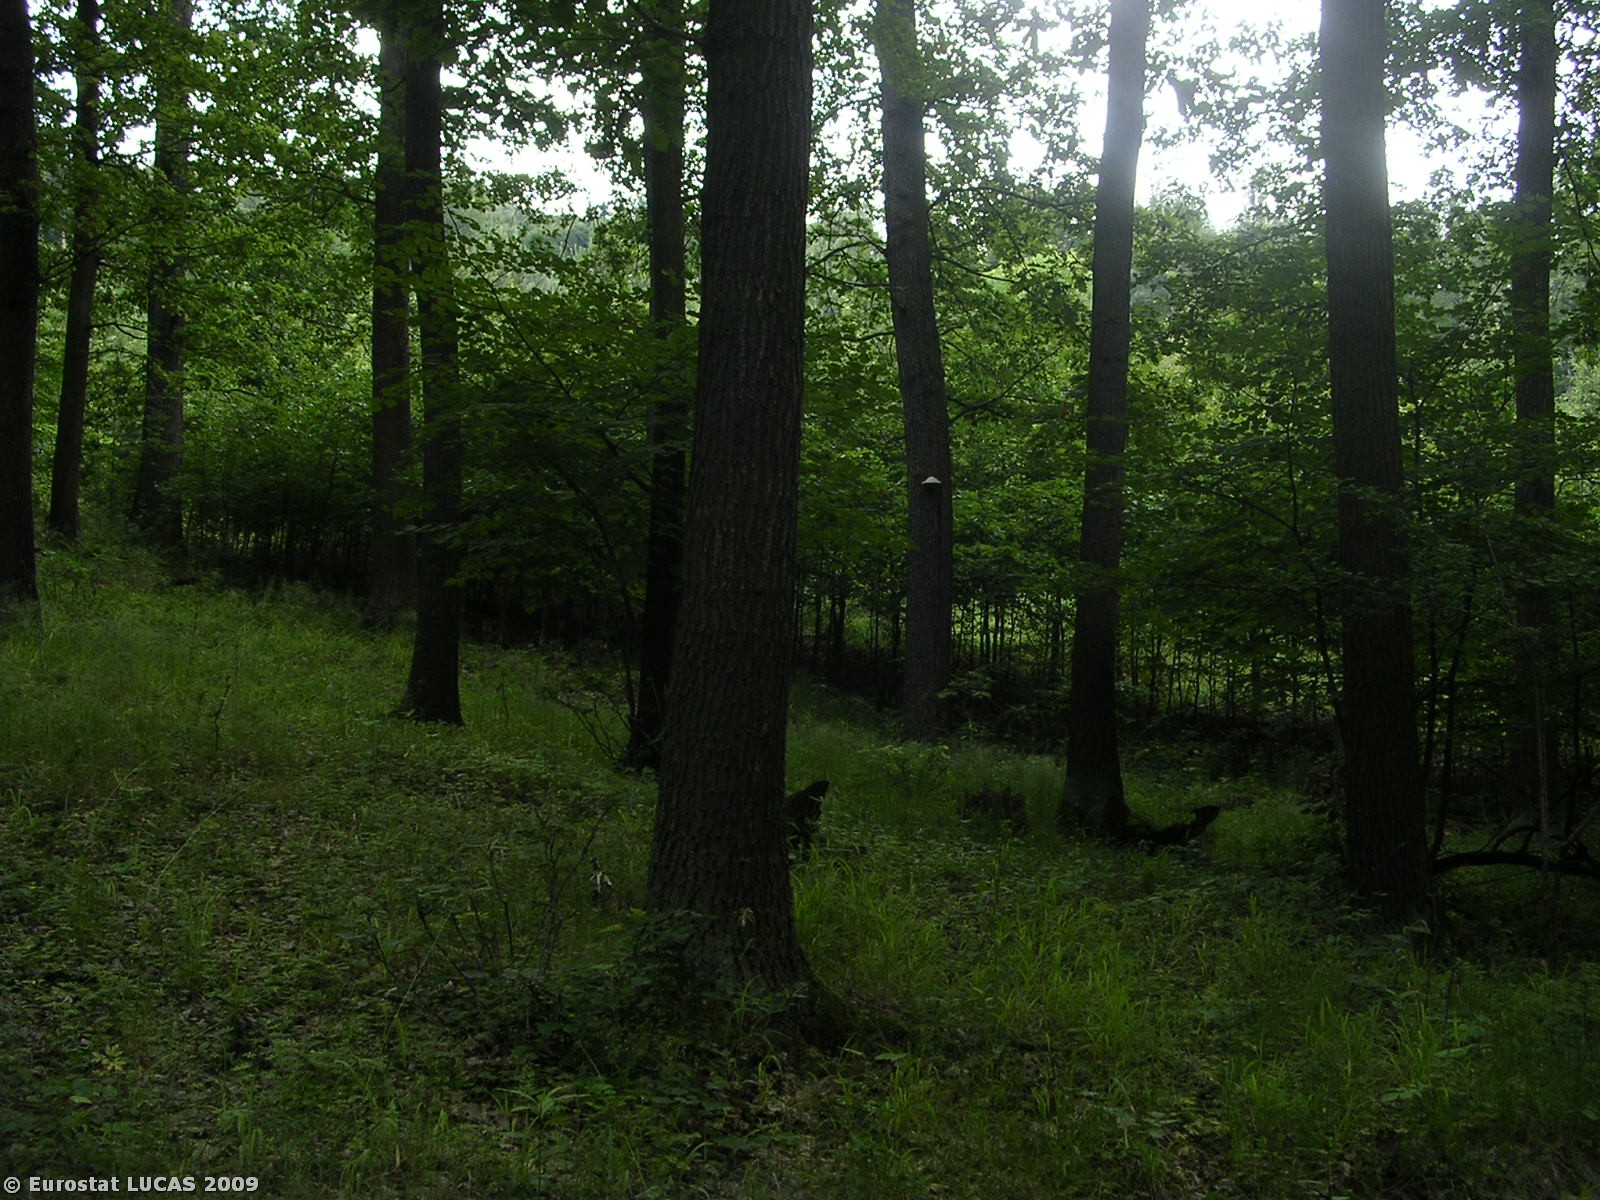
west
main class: Woodland
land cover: Broadleaved woodland
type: acidophilous oak and oak-birch forest
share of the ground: > 75 %
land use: Forestry
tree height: > 5 m
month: June
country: CZ
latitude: 50.5932
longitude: 14.1968
